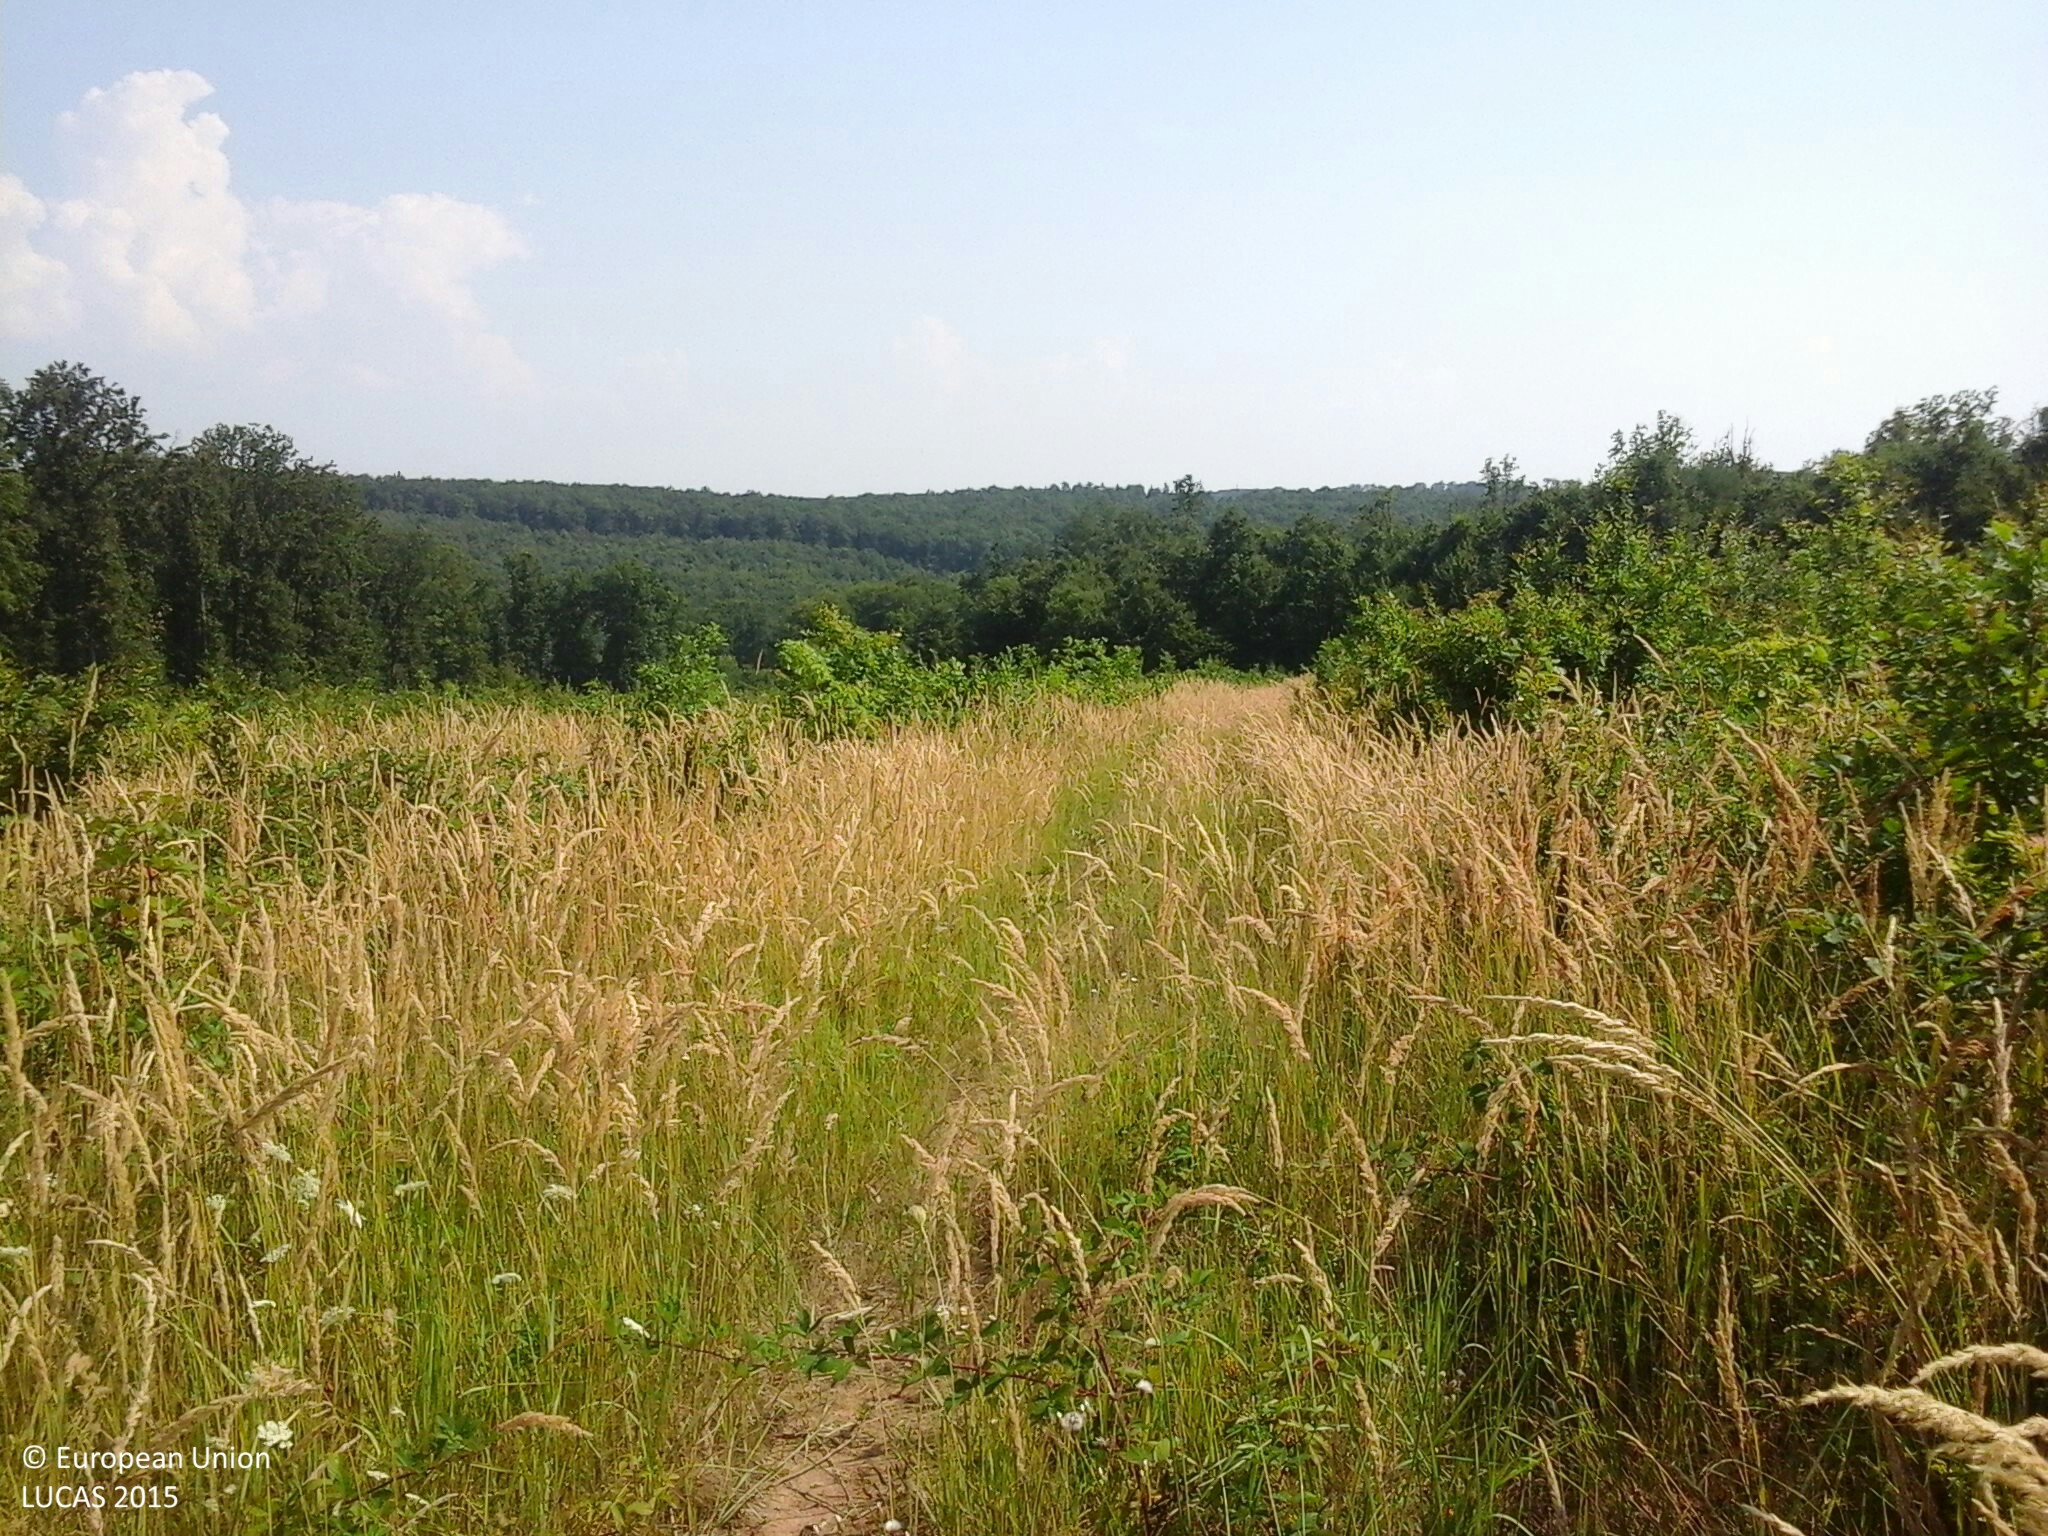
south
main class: Woodland
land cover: Broadleaved woodland
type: mesophytic deciduous forest
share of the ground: 50 - 75 %
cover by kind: broadleaved forest trees 50 %, herbaceous plants 30 %, shrubs 20 %
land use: Forestry
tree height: < 5 m
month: August
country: HU
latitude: 46.1384
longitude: 18.2794
